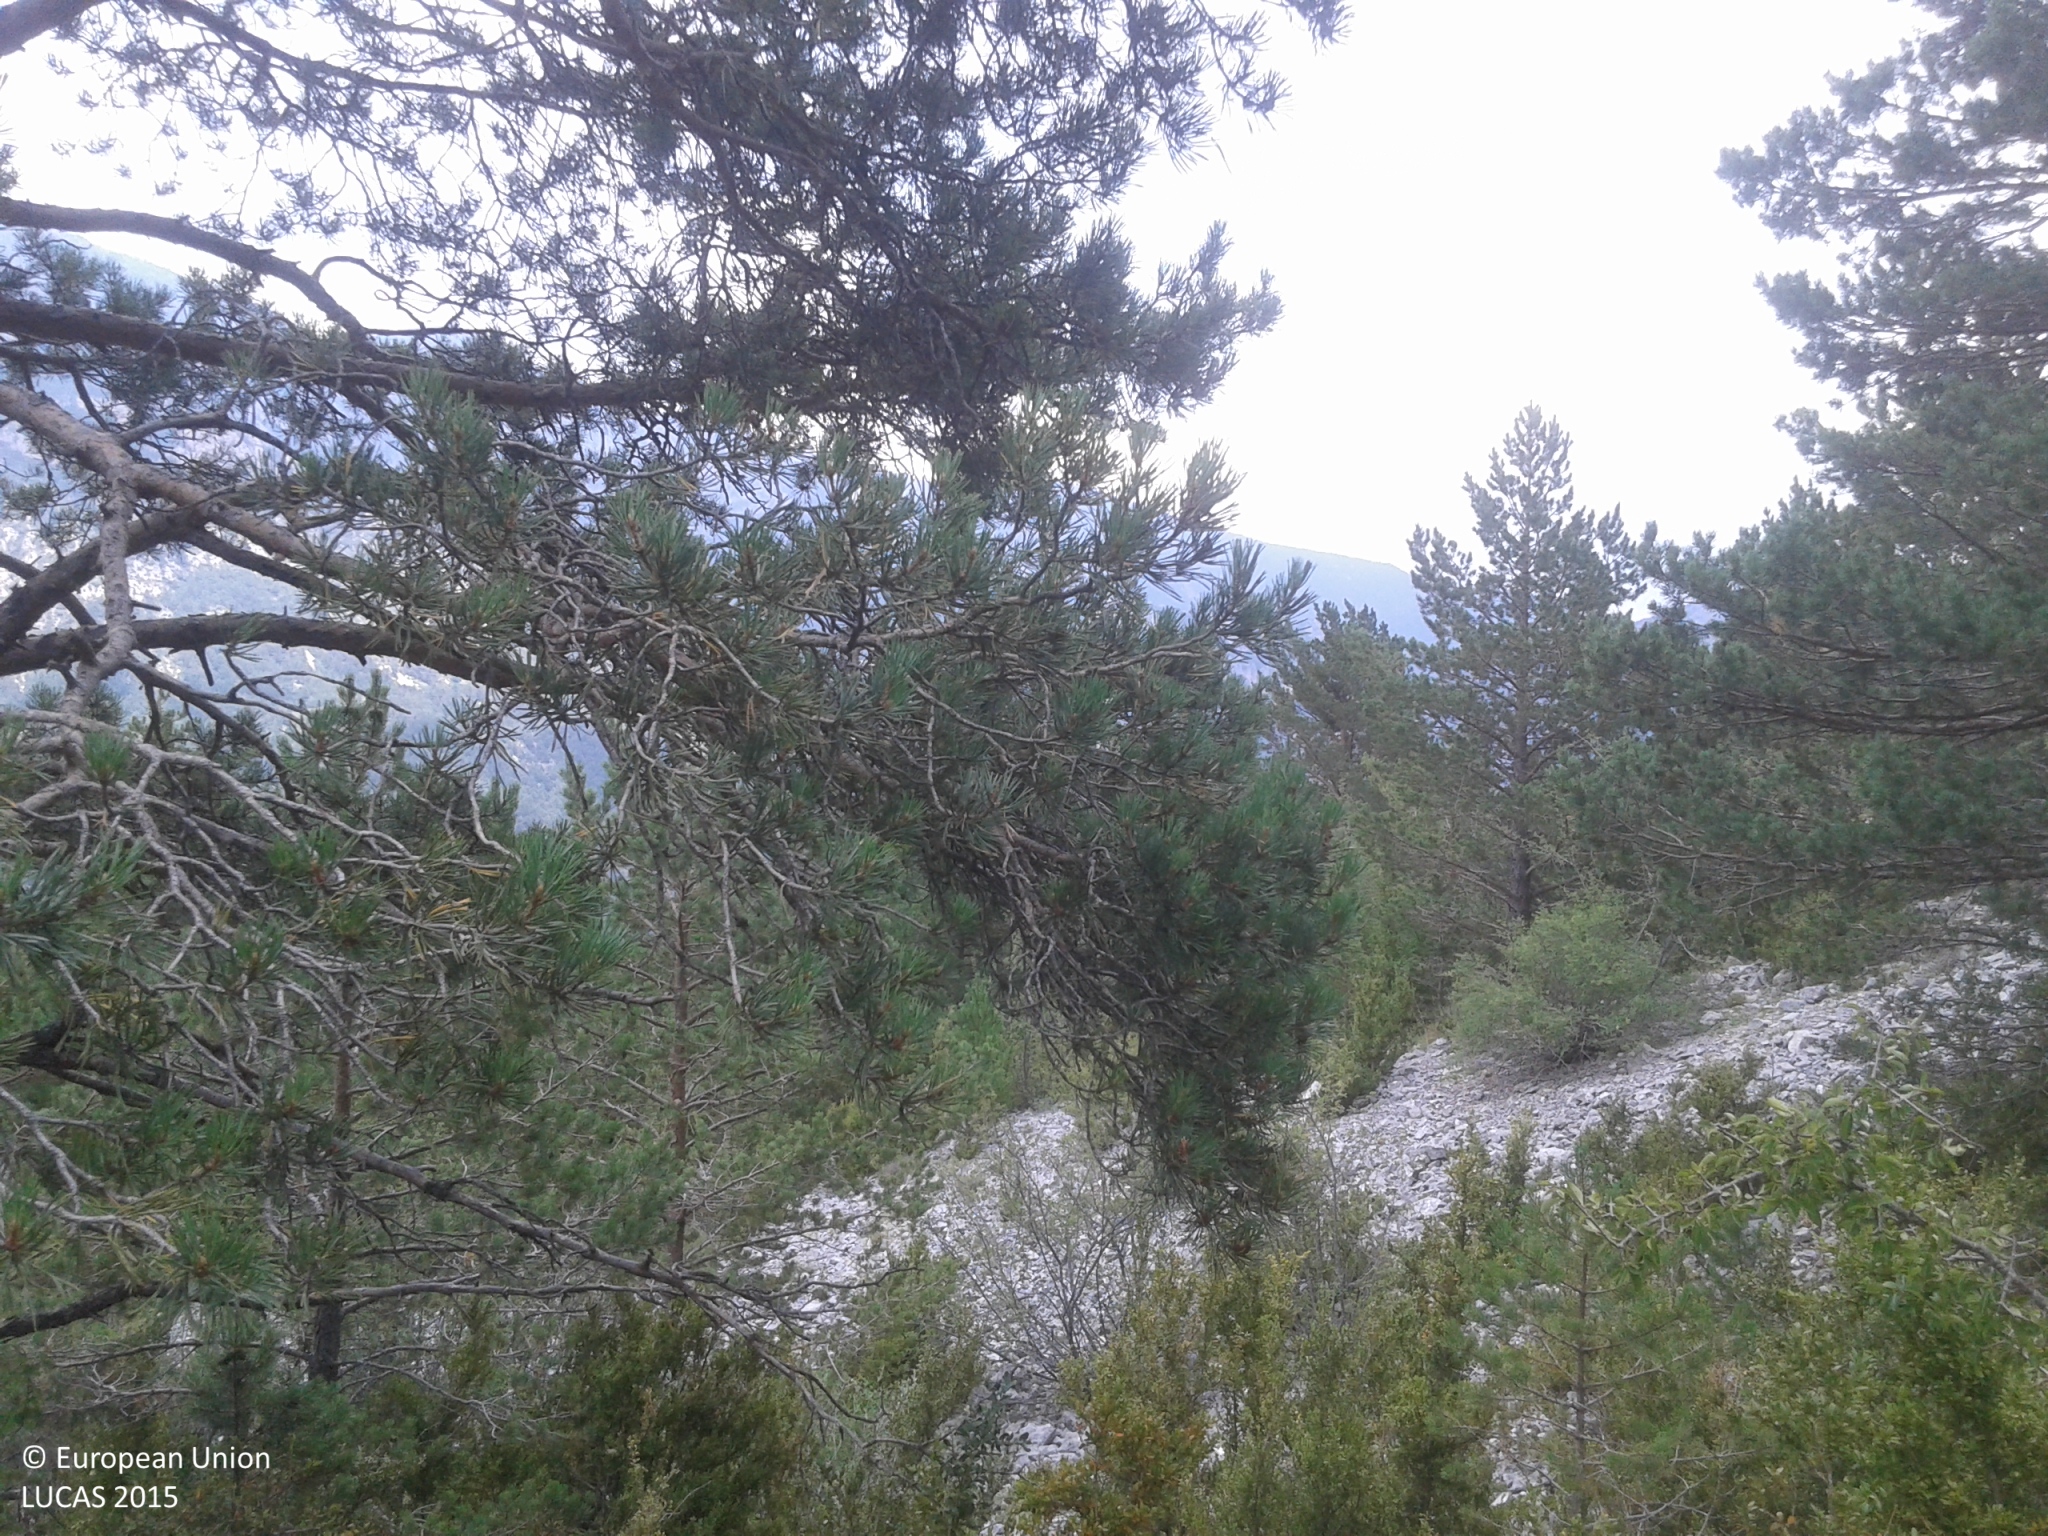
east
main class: Woodland
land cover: Pine dominated coniferous woodland
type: alpine coniferous forest
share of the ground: 25 - 50 %
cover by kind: consolidated bare surface 40 %, shrubs 30 %, coniferous forest trees 25 %, herbaceous plants 5 %
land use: Semi-natural and natural areas not in use
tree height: > 5 m
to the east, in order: Pine dominated coniferous woodland; Tracks; Pine dominated coniferous woodland; Tracks; Pine dominated coniferous woodland; Grassland with sparse tree/shrub cover; Tracks; Electric lines; Shrubland without tree cover; Tracks; Shrubland without tree cover; Grassland with sparse tree/shrub cover; Shrubland without tree cover
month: July
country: ES
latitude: 42.1753
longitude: 1.5736
